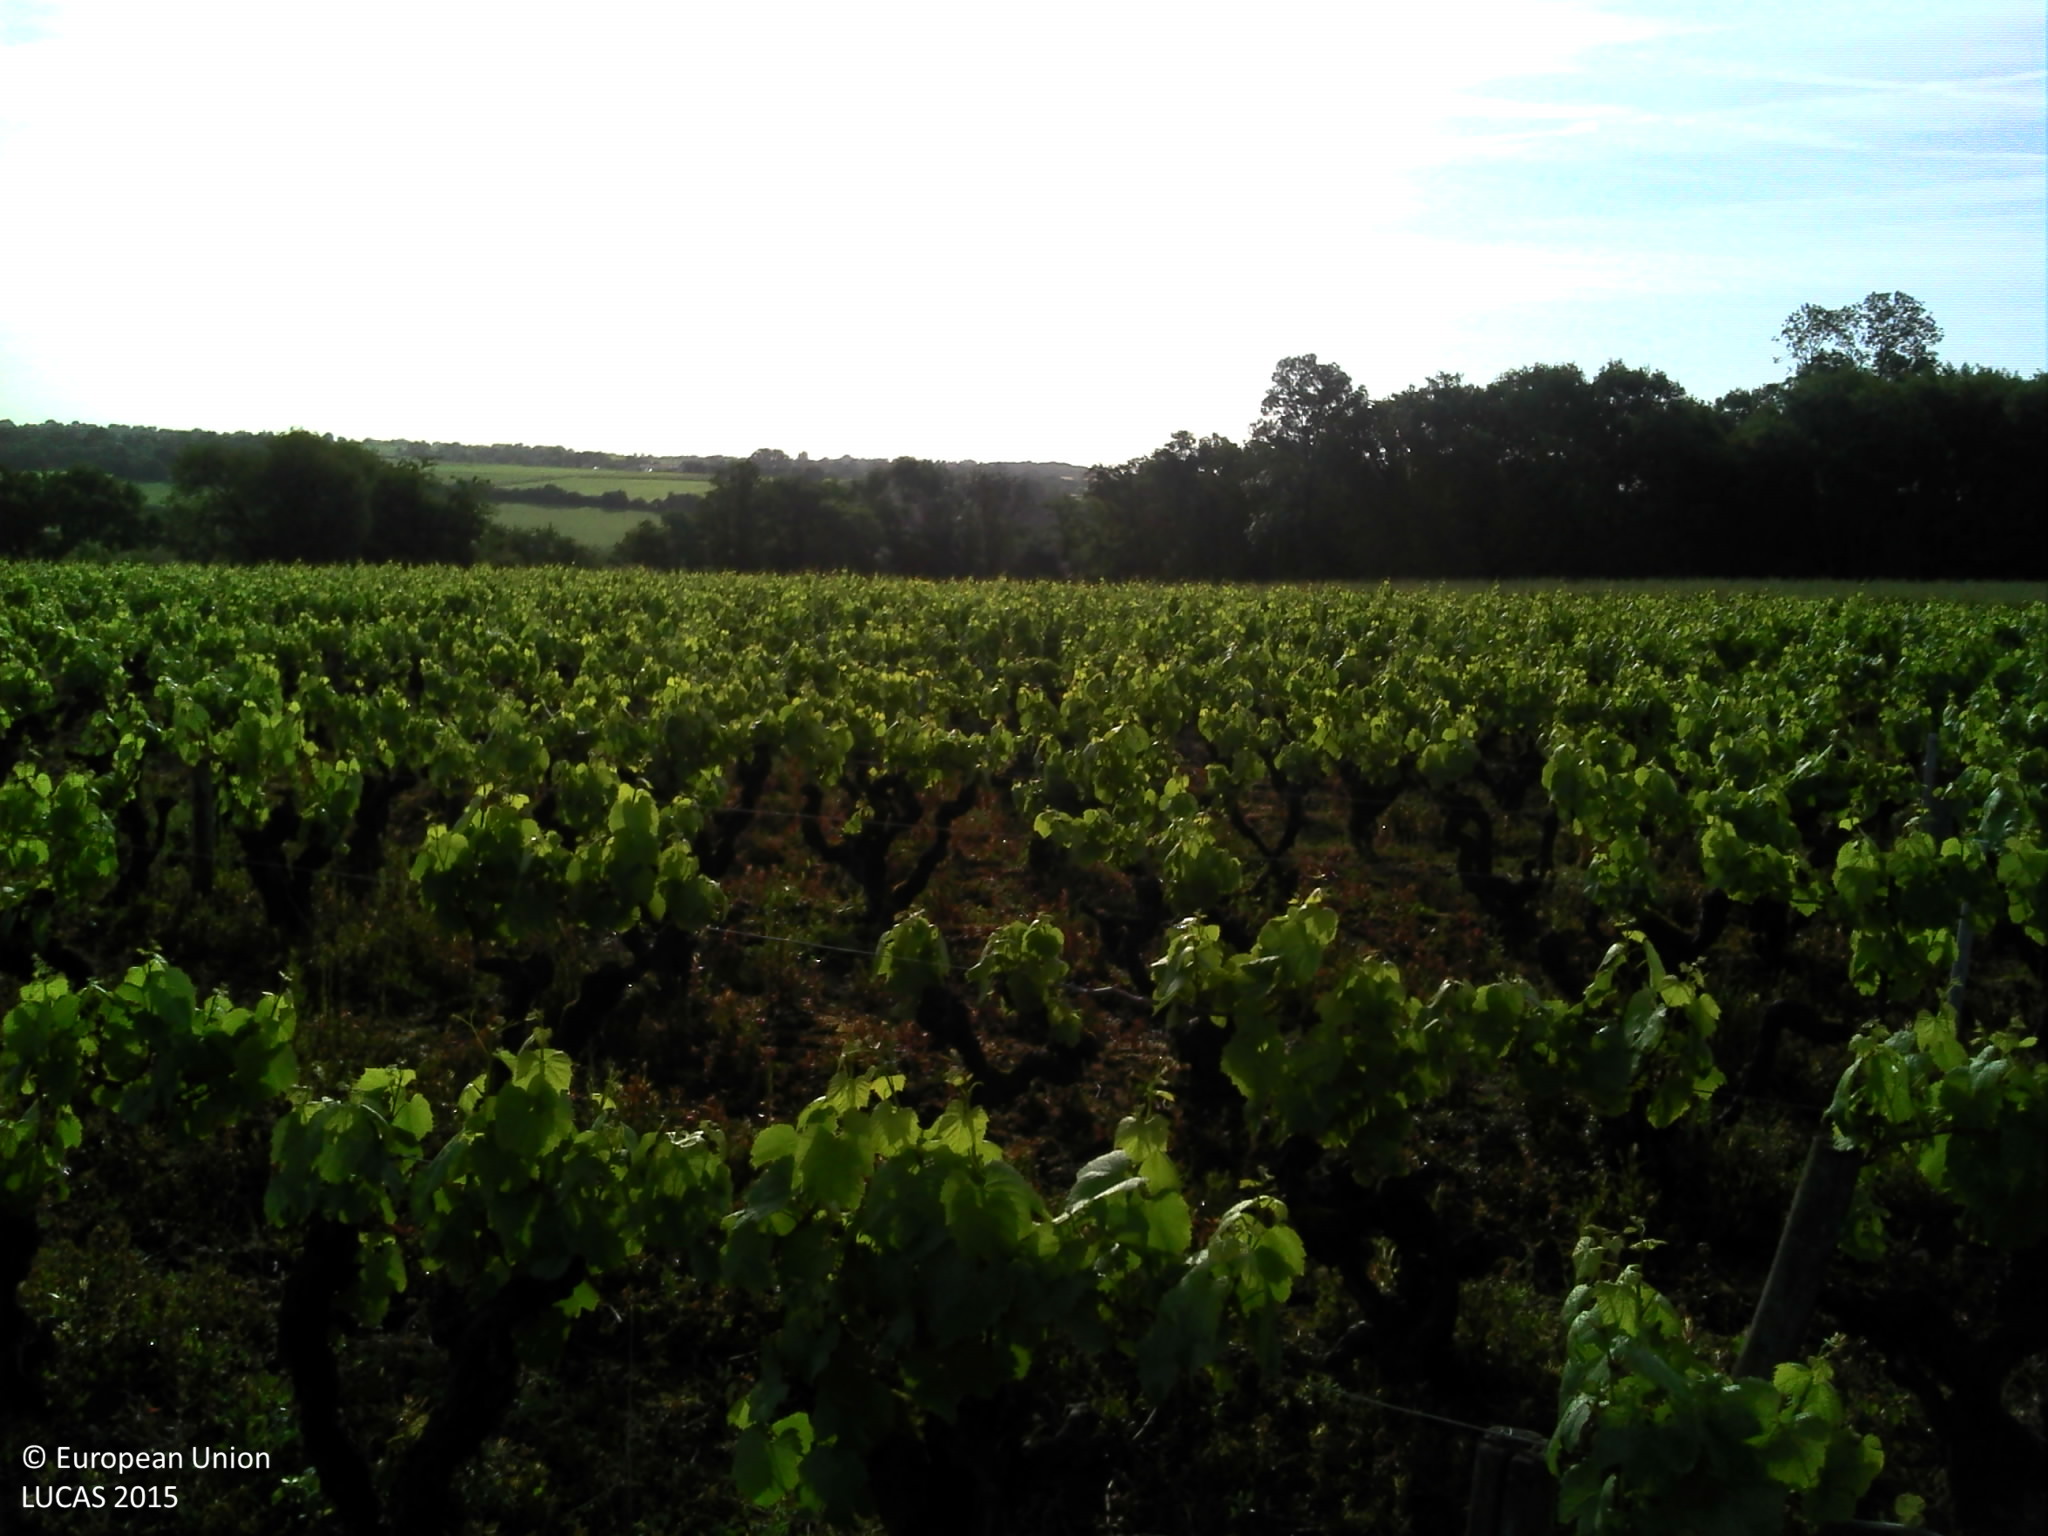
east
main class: Cropland
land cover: Vineyards
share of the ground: > 75 %
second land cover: Spontaneously vegetated surfaces
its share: 25 - 50 %
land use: Agriculture (excluding fallow land and kitchen gardens)
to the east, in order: Vineyards; Spontaneously vegetated surfaces; Ditches and canals; Tracks; Ditches and canals; Managed hedges; Common wheat; Fences; Abandoned hedges; Grassland without tree/shrub cover; Broadleaved woodland; Fences; Ditches and canals; Broadleaved woodland; Grassland without tree/shrub cover
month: June
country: FR
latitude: 47.2960
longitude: -1.2930
